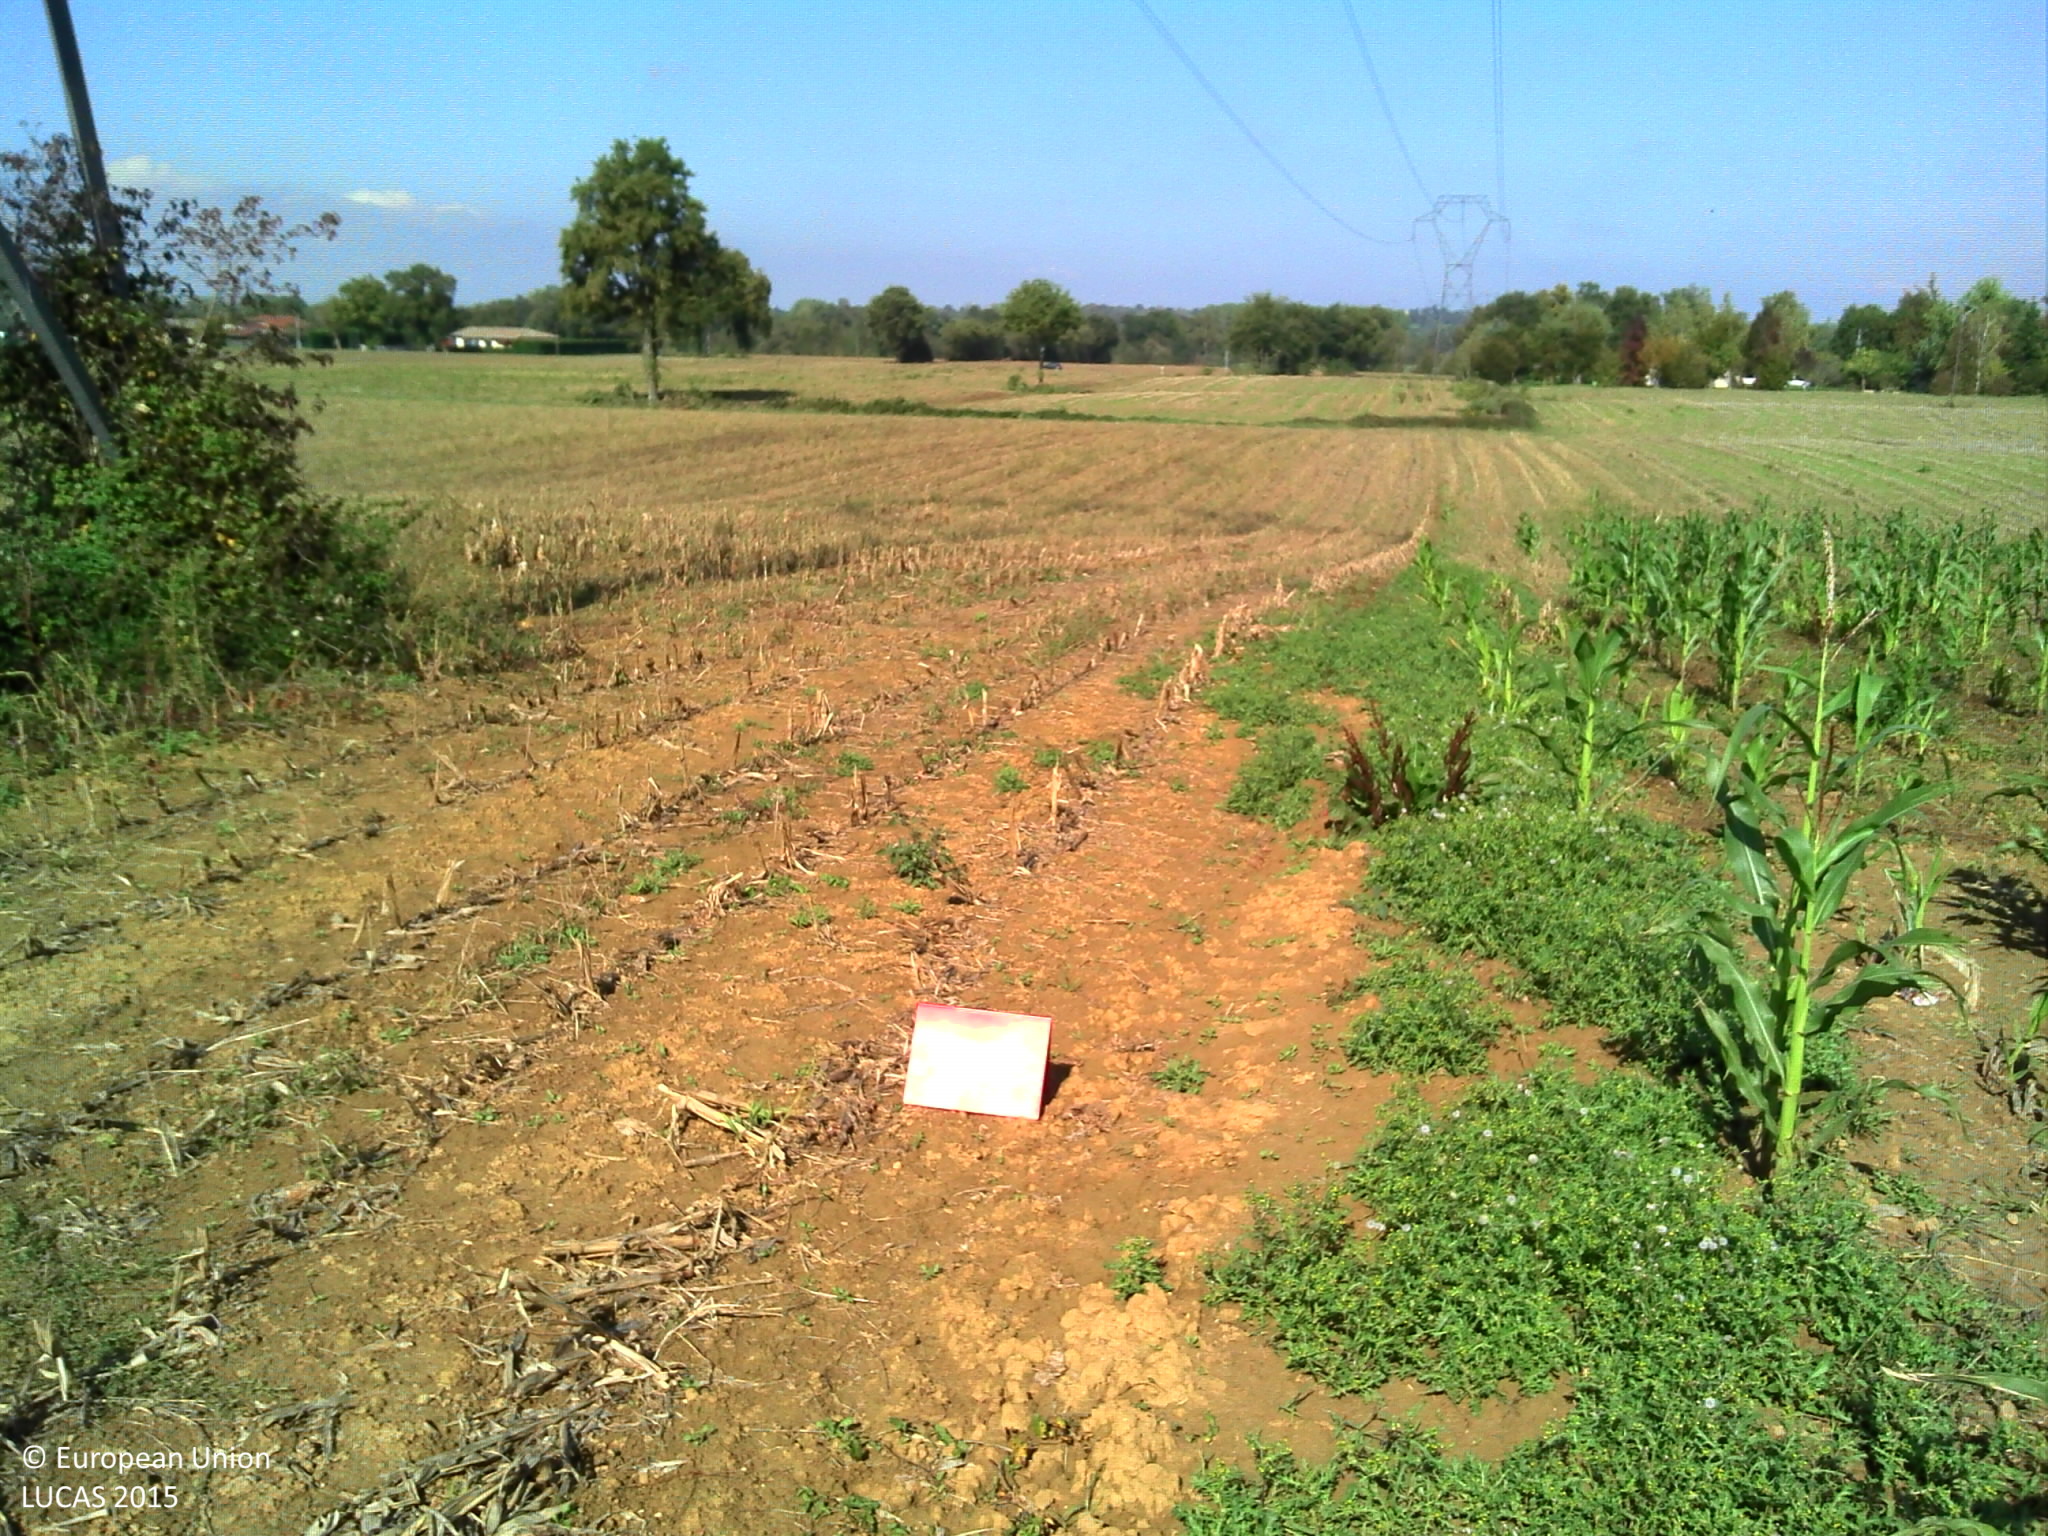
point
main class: Cropland
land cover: Maize
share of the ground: < 10 %
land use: Agriculture (excluding fallow land and kitchen gardens)
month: October
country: FR
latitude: 46.2479
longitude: 4.9051
